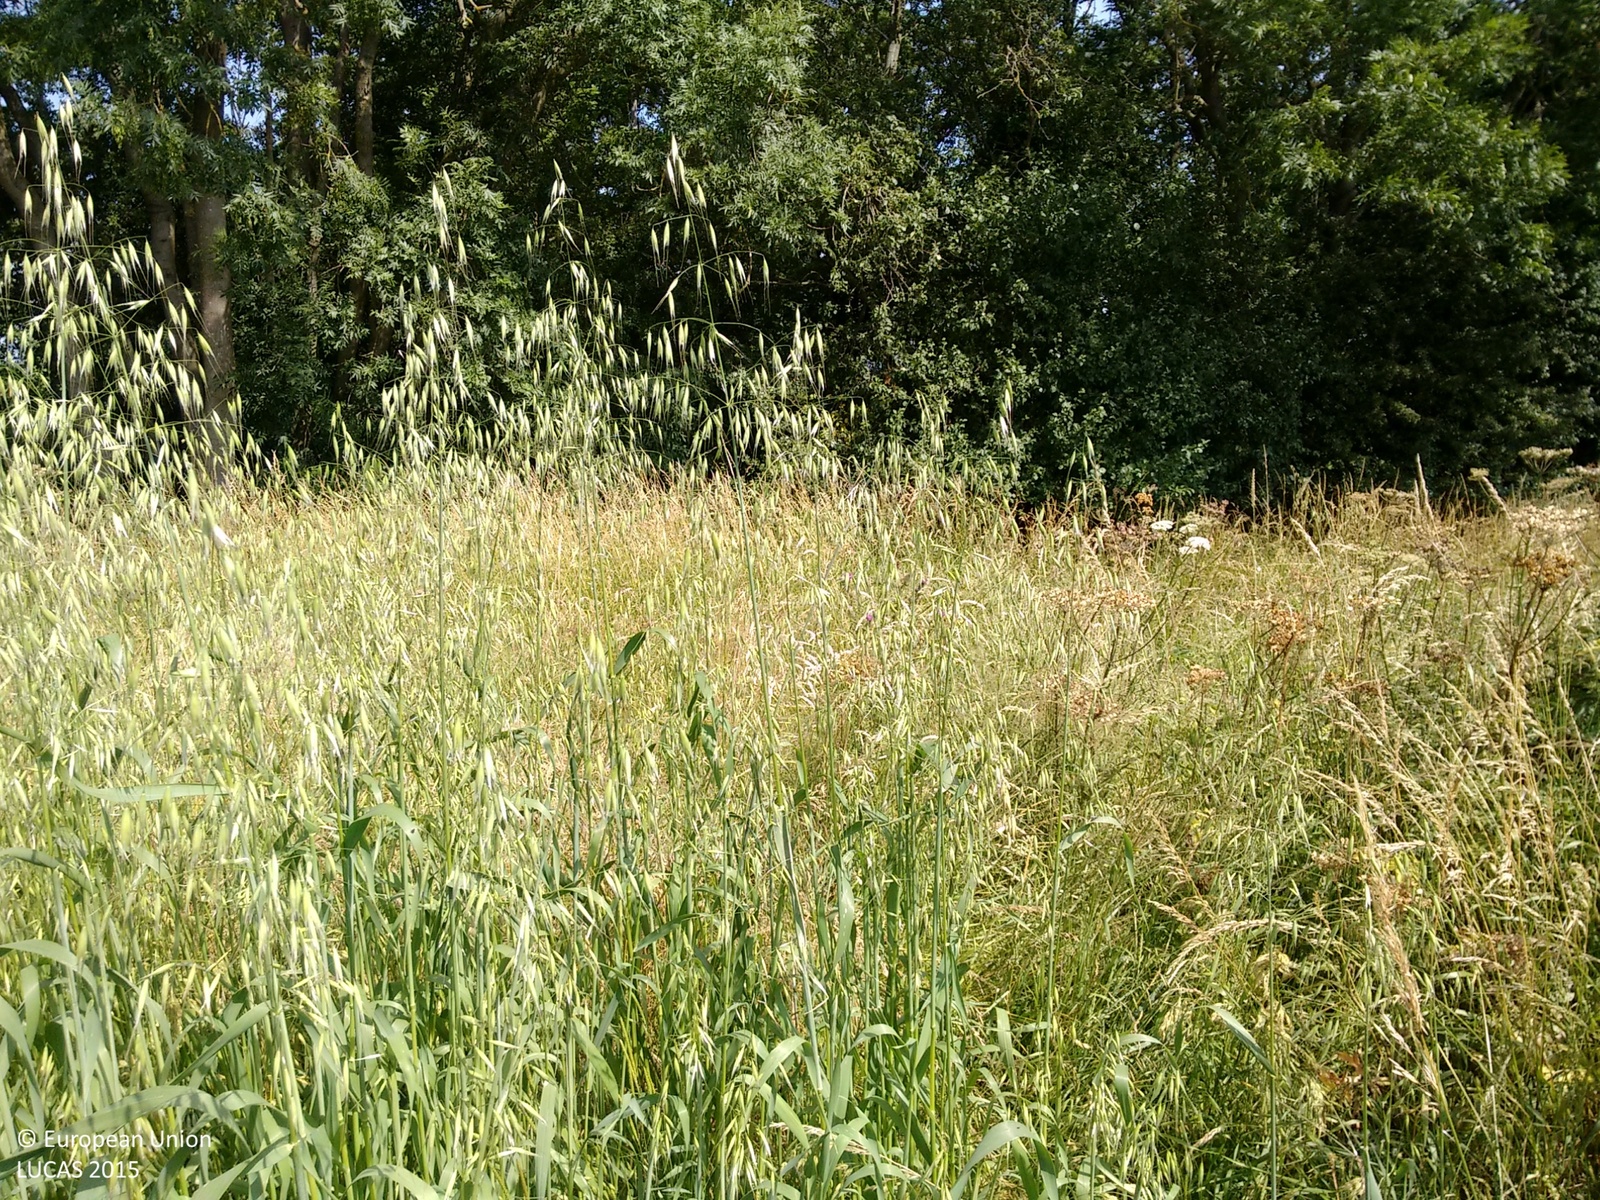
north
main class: Cropland
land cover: Common wheat
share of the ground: > 75 %
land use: Agriculture (excluding fallow land and kitchen gardens)
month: July
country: GB
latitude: 53.1690
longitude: -0.8270
